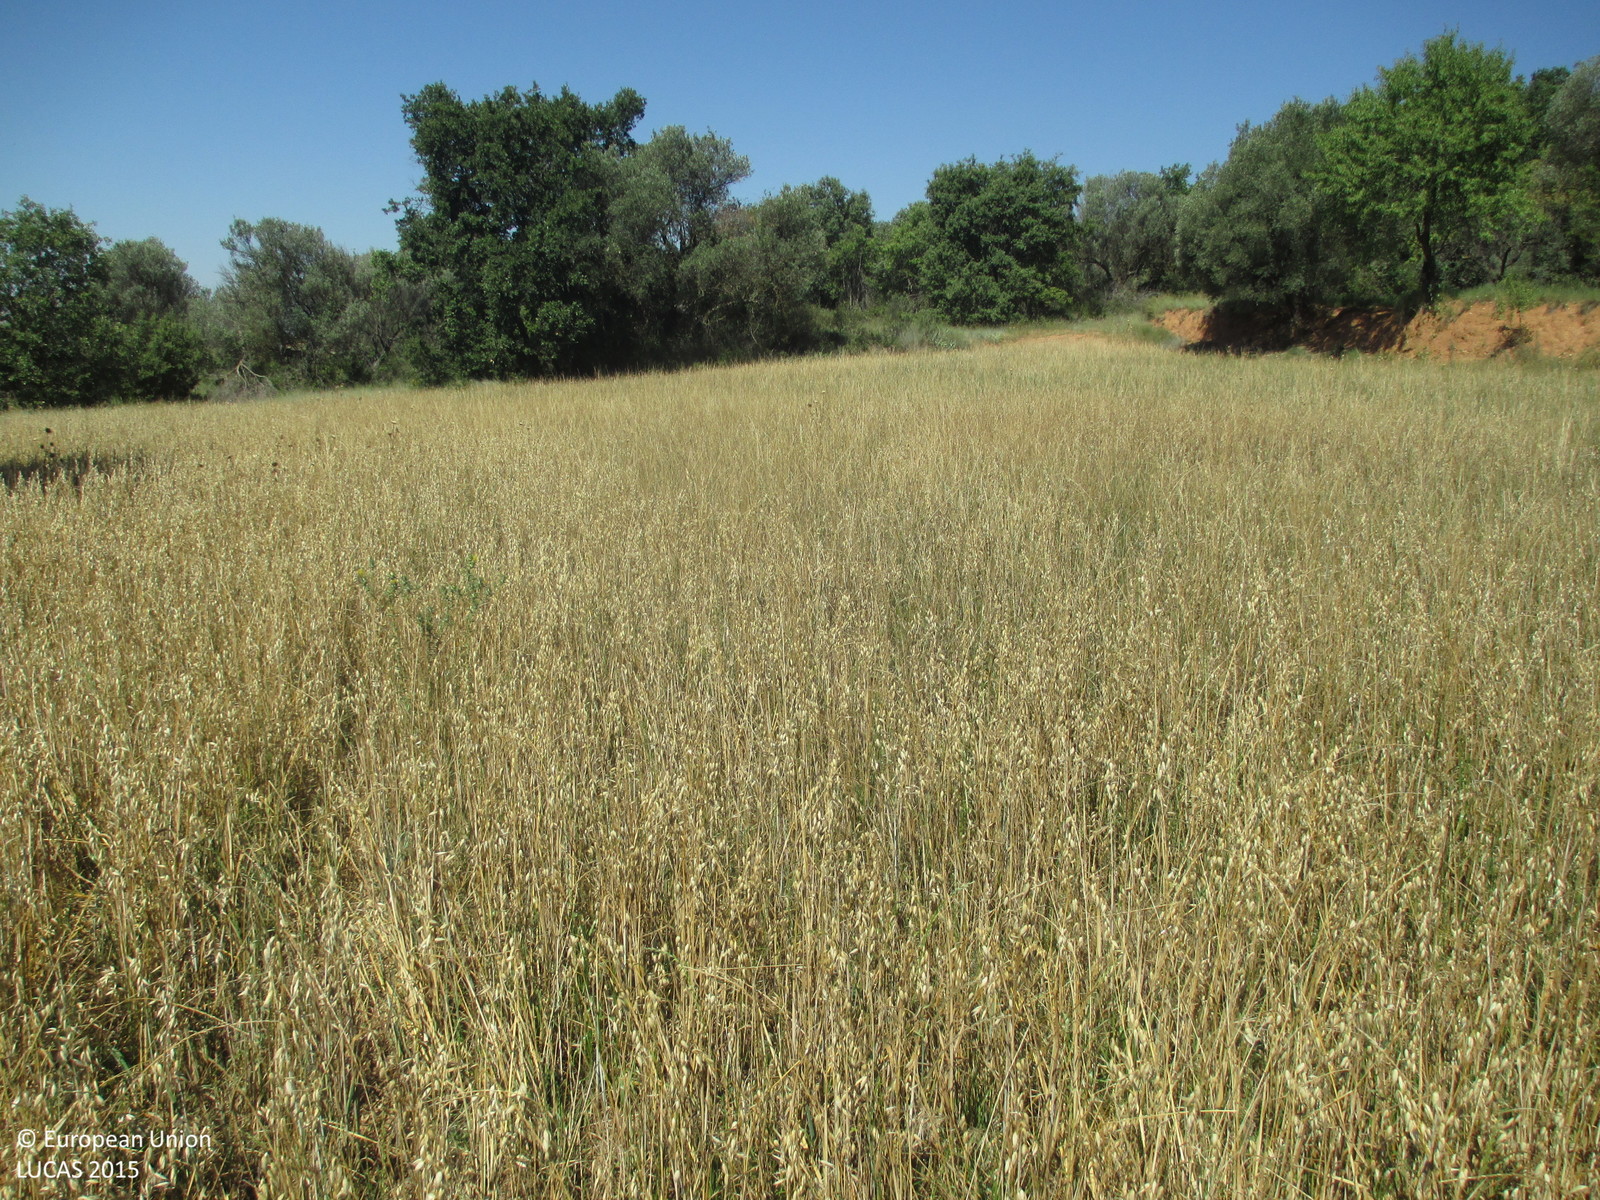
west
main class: Cropland
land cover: Mixed cereals for fodder
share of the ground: > 75 %
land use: Agriculture (excluding fallow land and kitchen gardens)
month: June
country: ES
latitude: 42.1730
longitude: -0.0317
